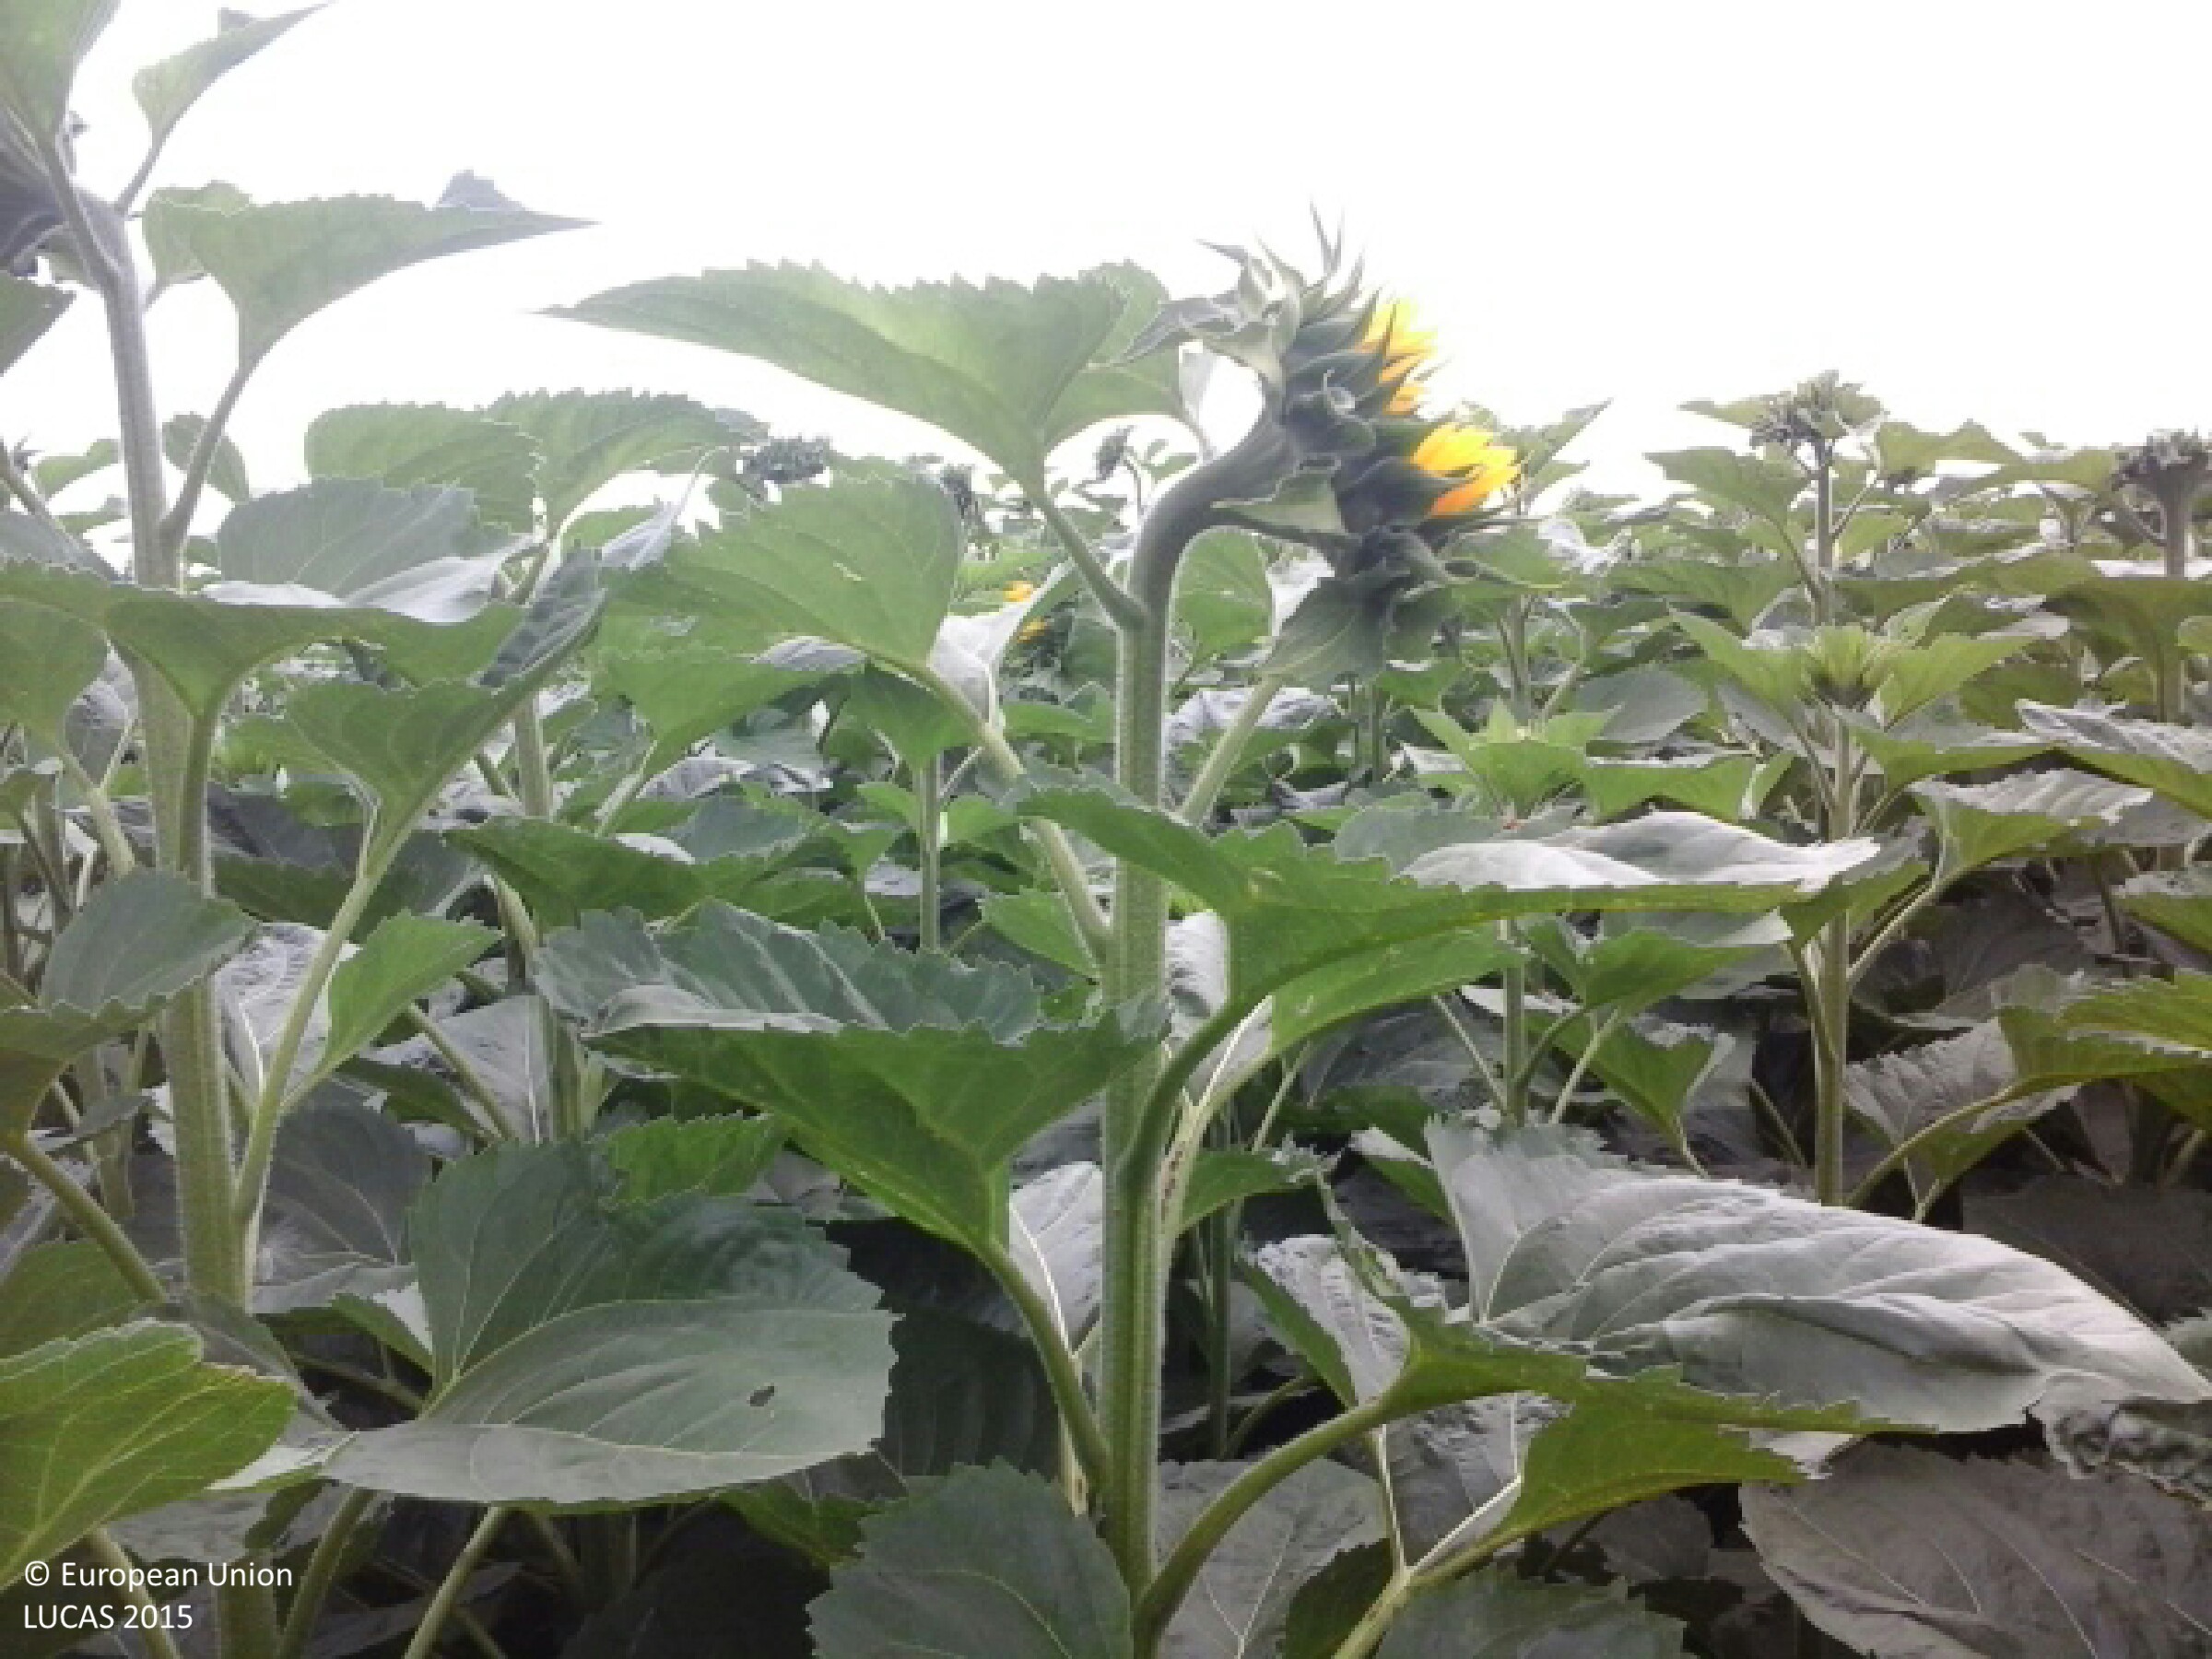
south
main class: Cropland
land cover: Sunflower
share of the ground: > 75 %
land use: Agriculture (excluding fallow land and kitchen gardens)
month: June
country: HU
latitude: 47.7779
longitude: 19.8884
